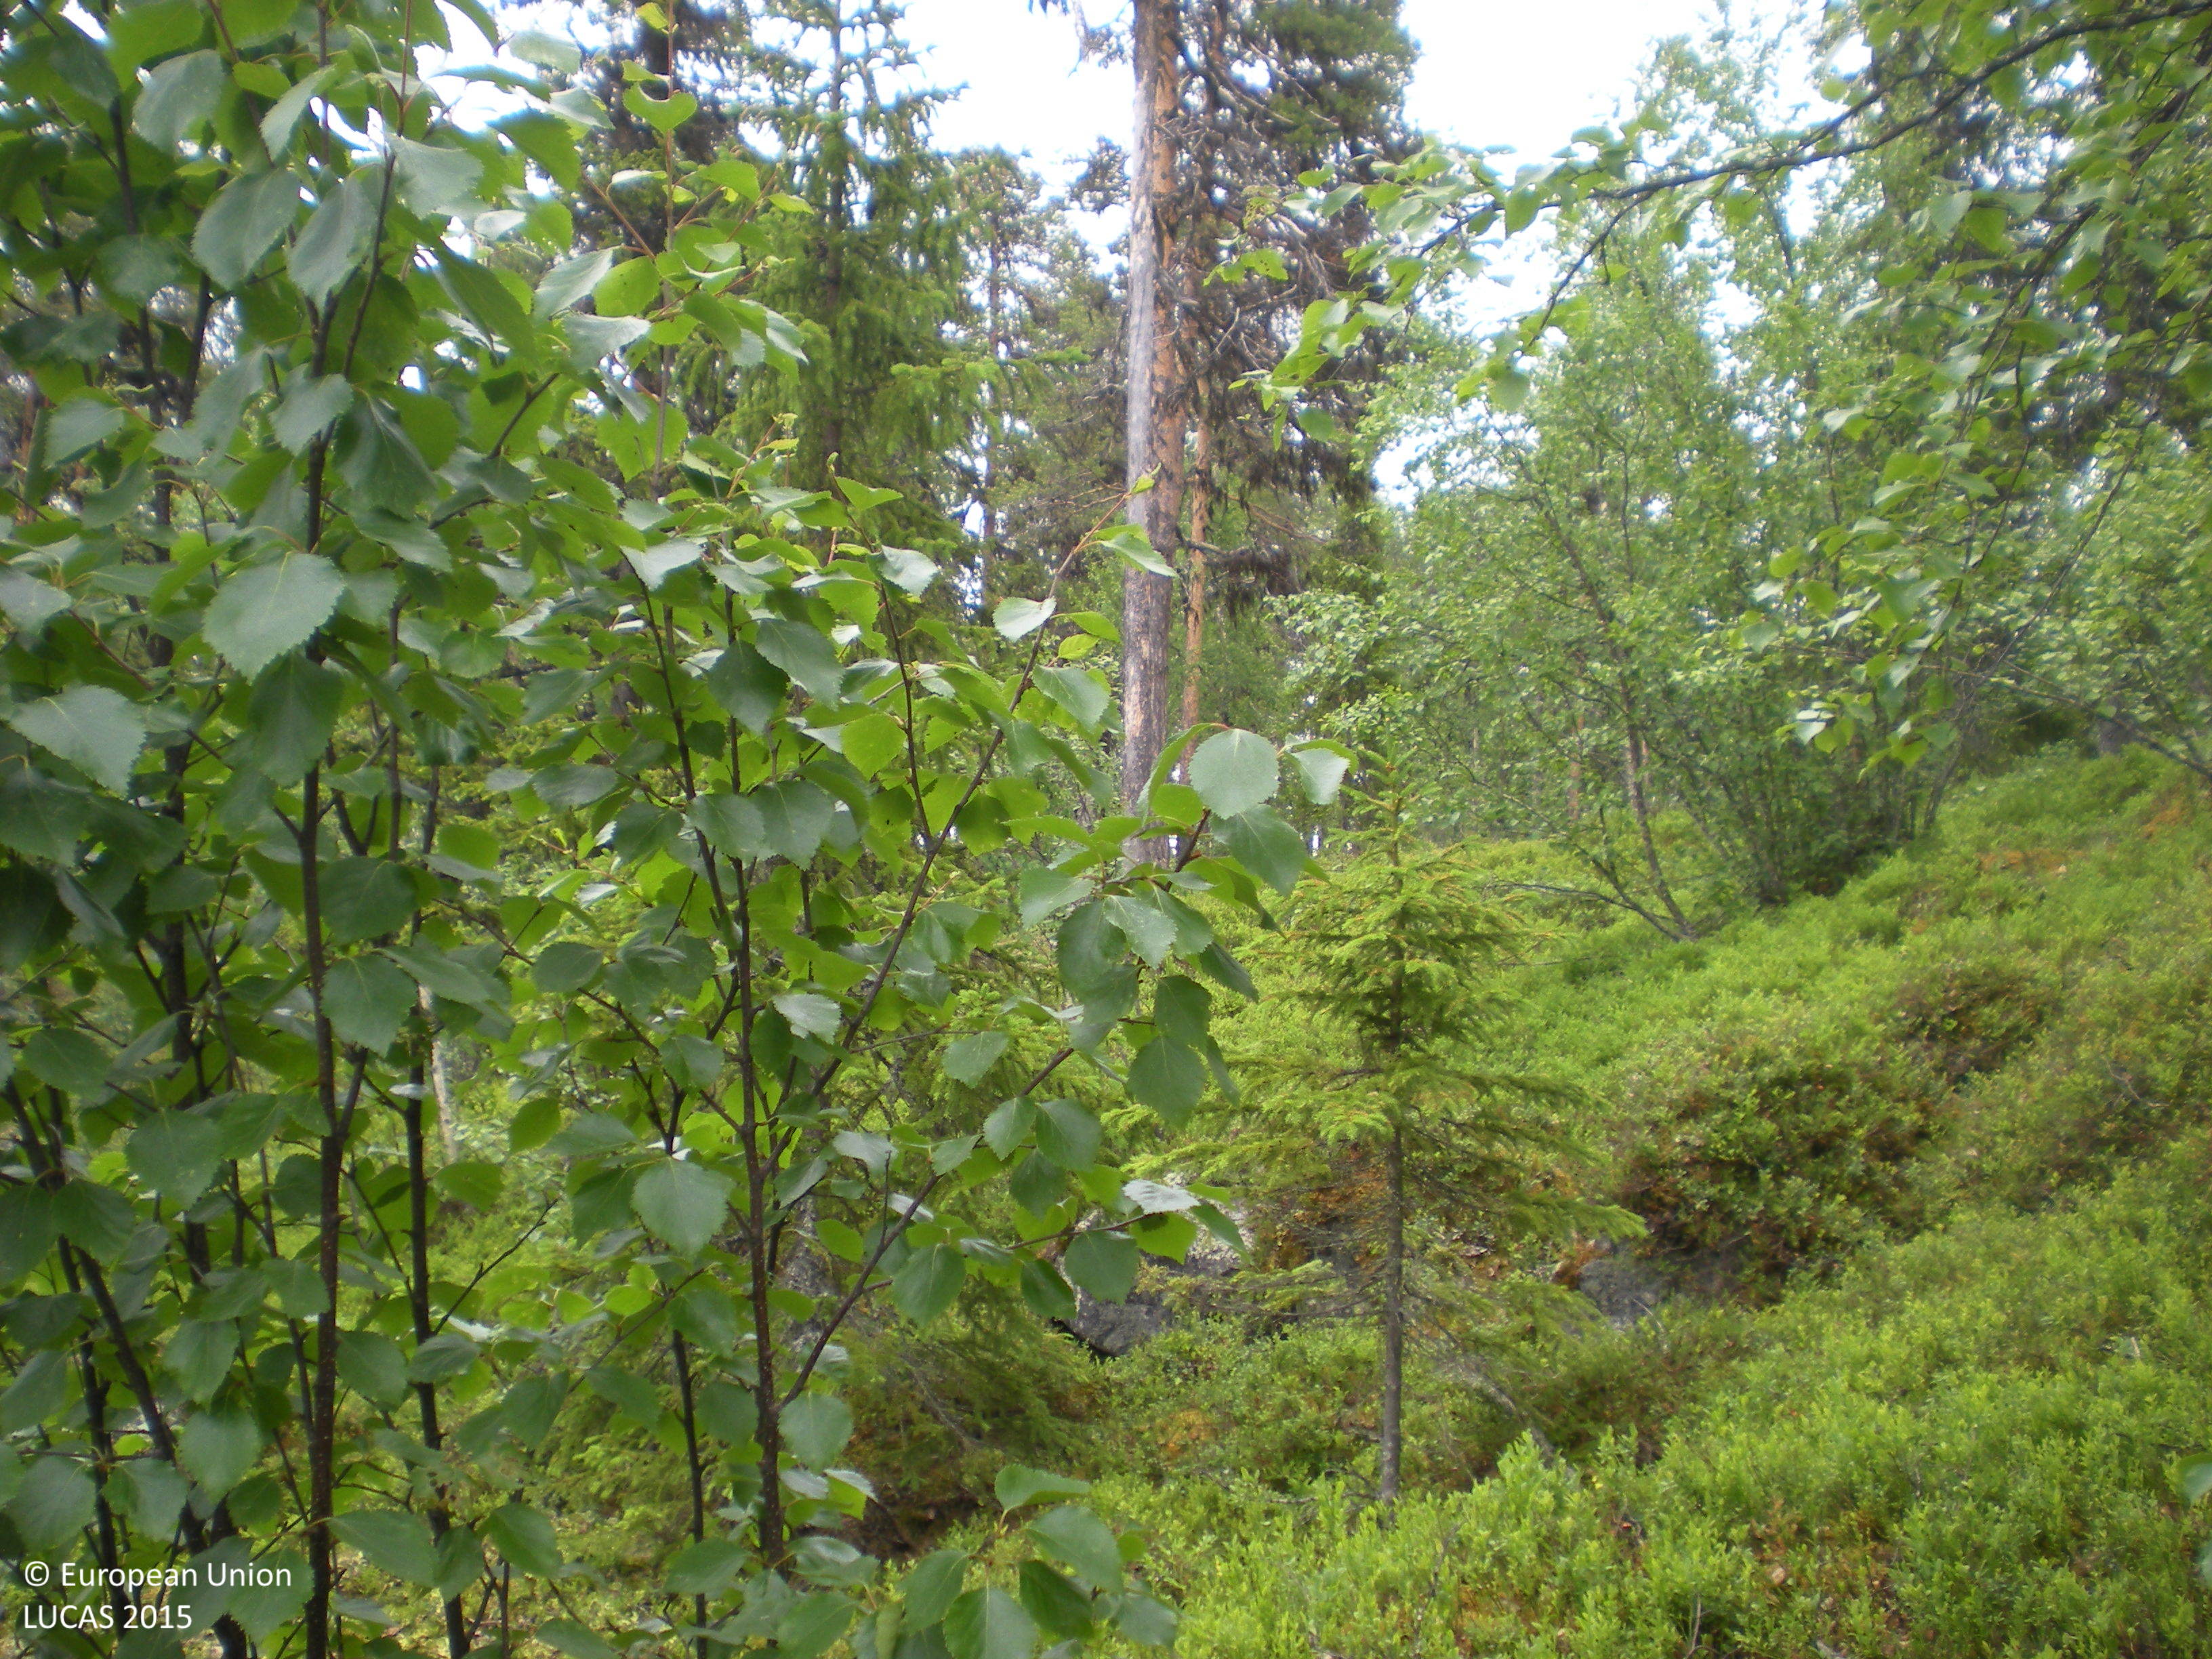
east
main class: Woodland
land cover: Pine dominated mixed woodland
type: boreal forest
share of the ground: 25 - 50 %
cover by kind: coniferous forest trees 30 %, shrubs 30 %, broadleaved forest trees 15 %, consolidated bare surface 15 %, lichens and mosses 10 %
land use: Forestry
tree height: > 5 m
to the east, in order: Pine dominated mixed woodland
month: July
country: SE
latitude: 65.5306
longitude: 17.0353
